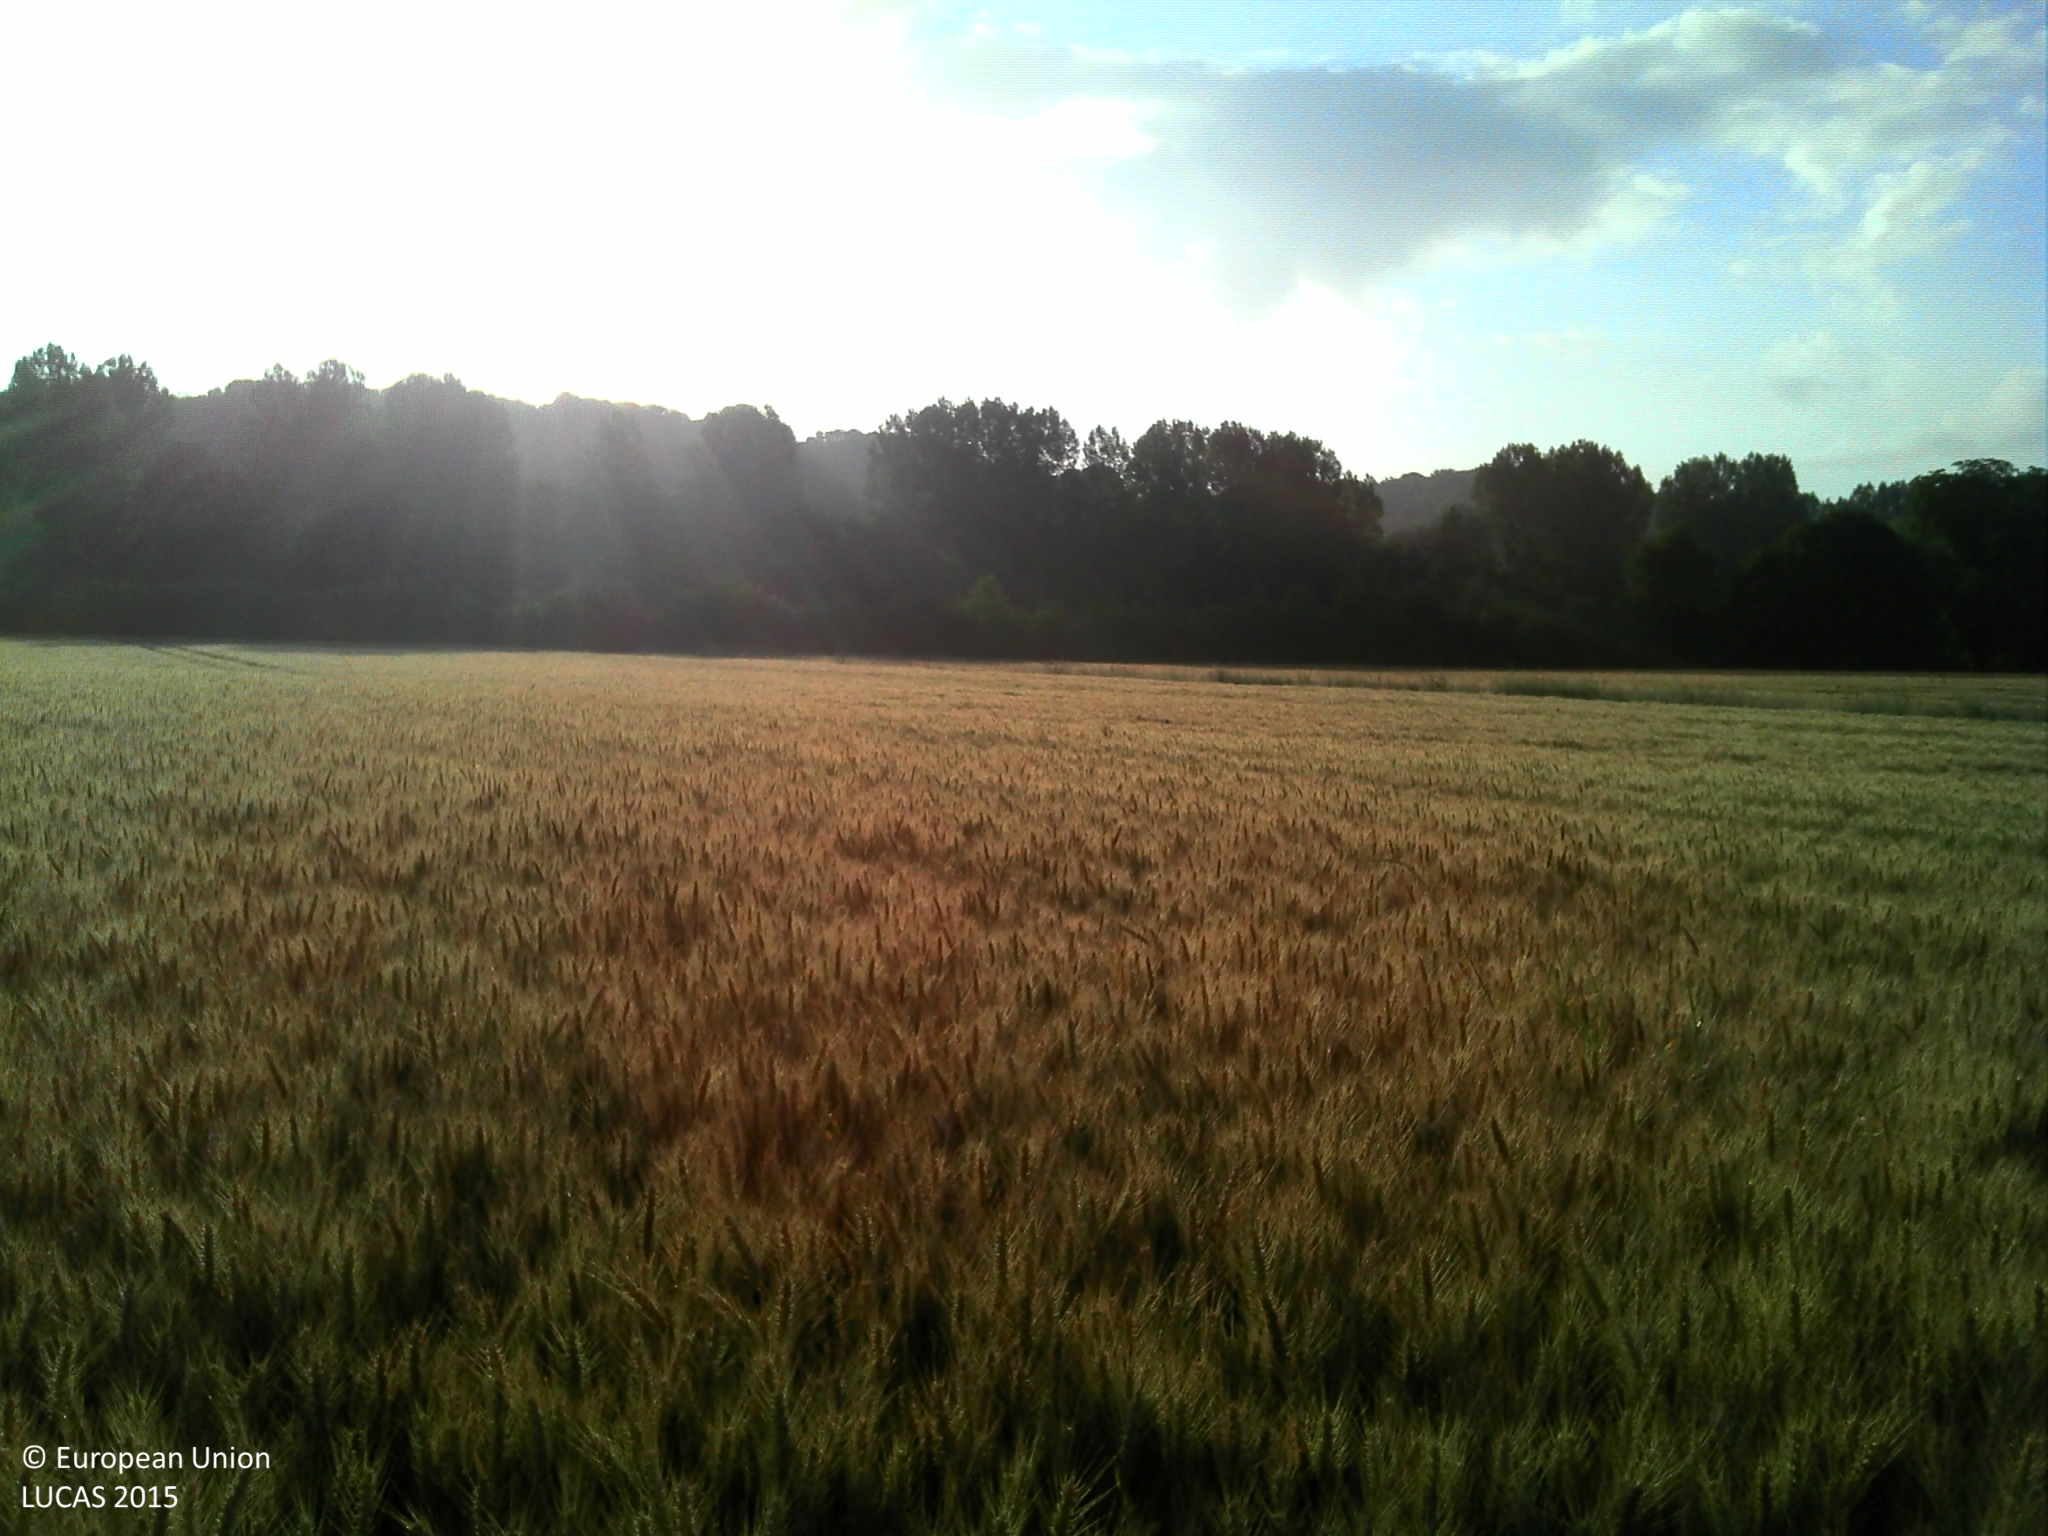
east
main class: Cropland
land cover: Common wheat
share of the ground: > 75 %
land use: Agriculture (excluding fallow land and kitchen gardens)
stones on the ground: < 10 %
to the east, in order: Common wheat; Managed hedges; Ditches and canals; Grass margins; Paved roads, cycling and walking lanes; Grass margins; Electric lines; Managed hedges; Fences; Grassland without tree/shrub cover
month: July
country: FR
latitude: 49.0745
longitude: 0.0172
